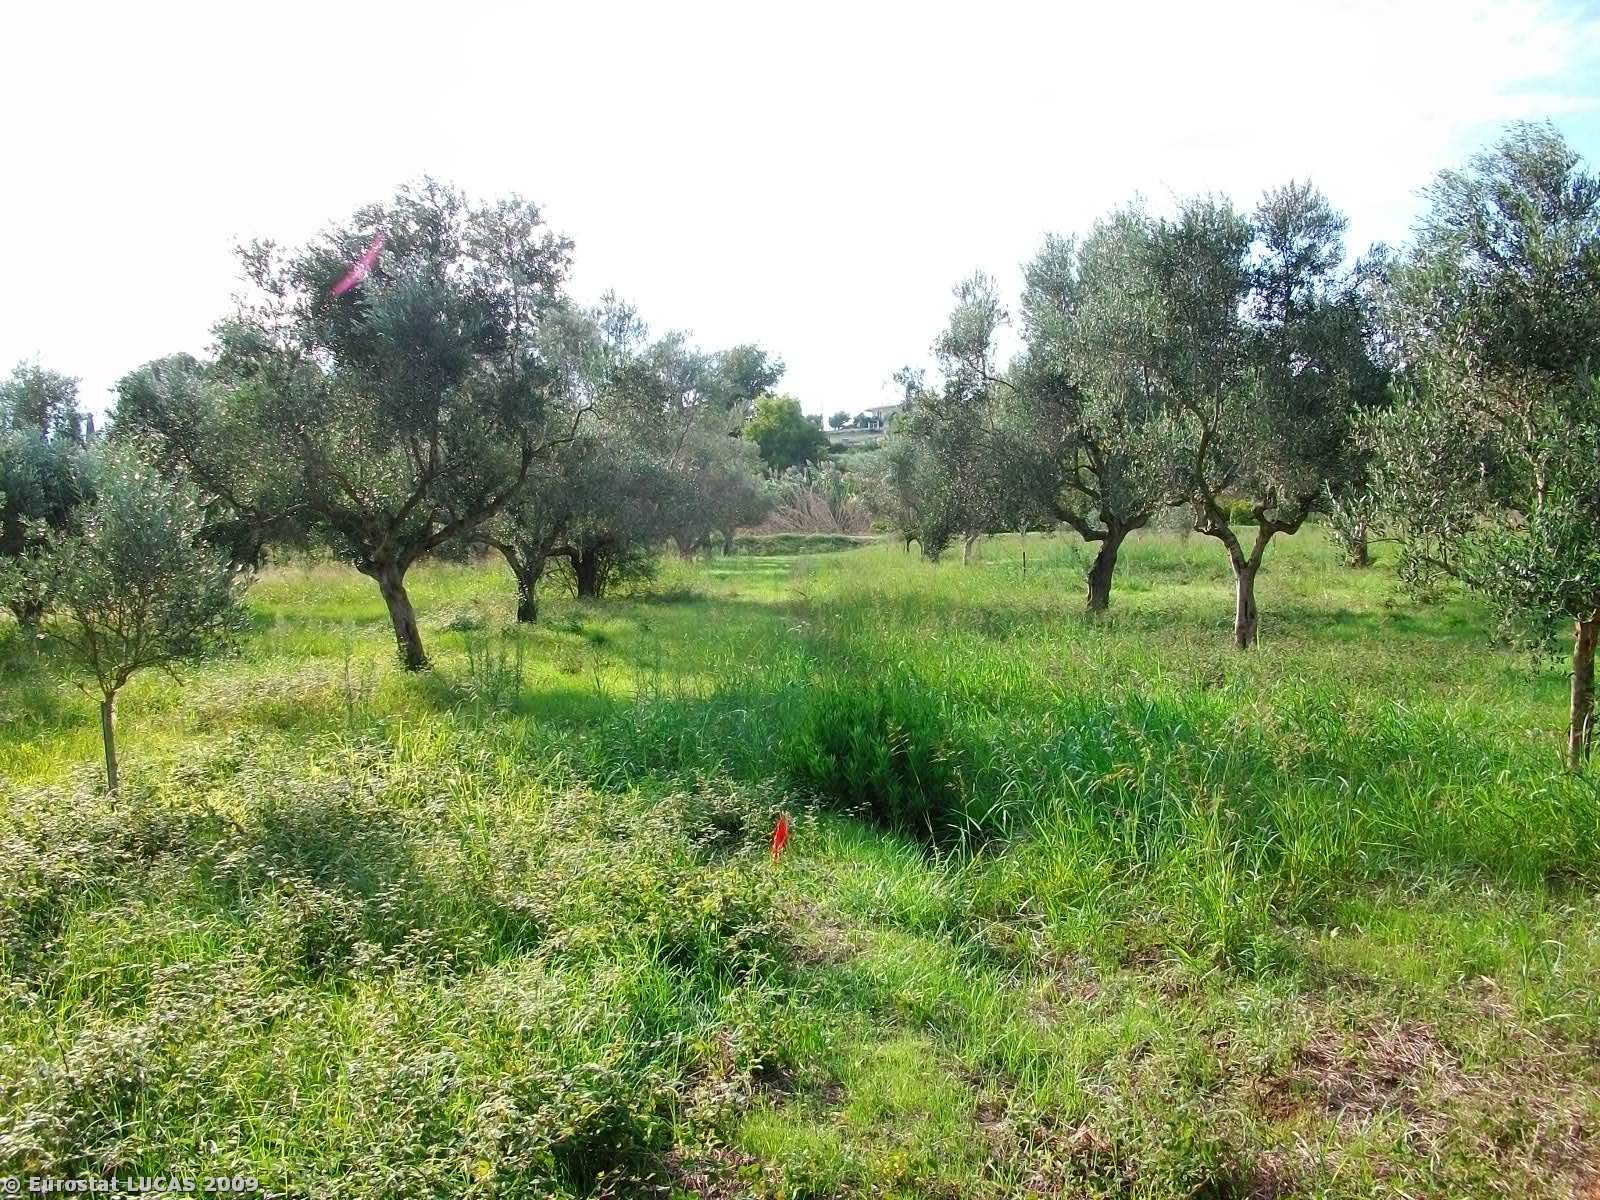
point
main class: Cropland
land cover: Olive groves
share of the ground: 10 - 25 %
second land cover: Grassland with sparse tree/shrub cover
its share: > 75 %
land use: Agriculture (excluding fallow land and kitchen gardens)
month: September
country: GR
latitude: 37.6898
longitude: 21.3327
